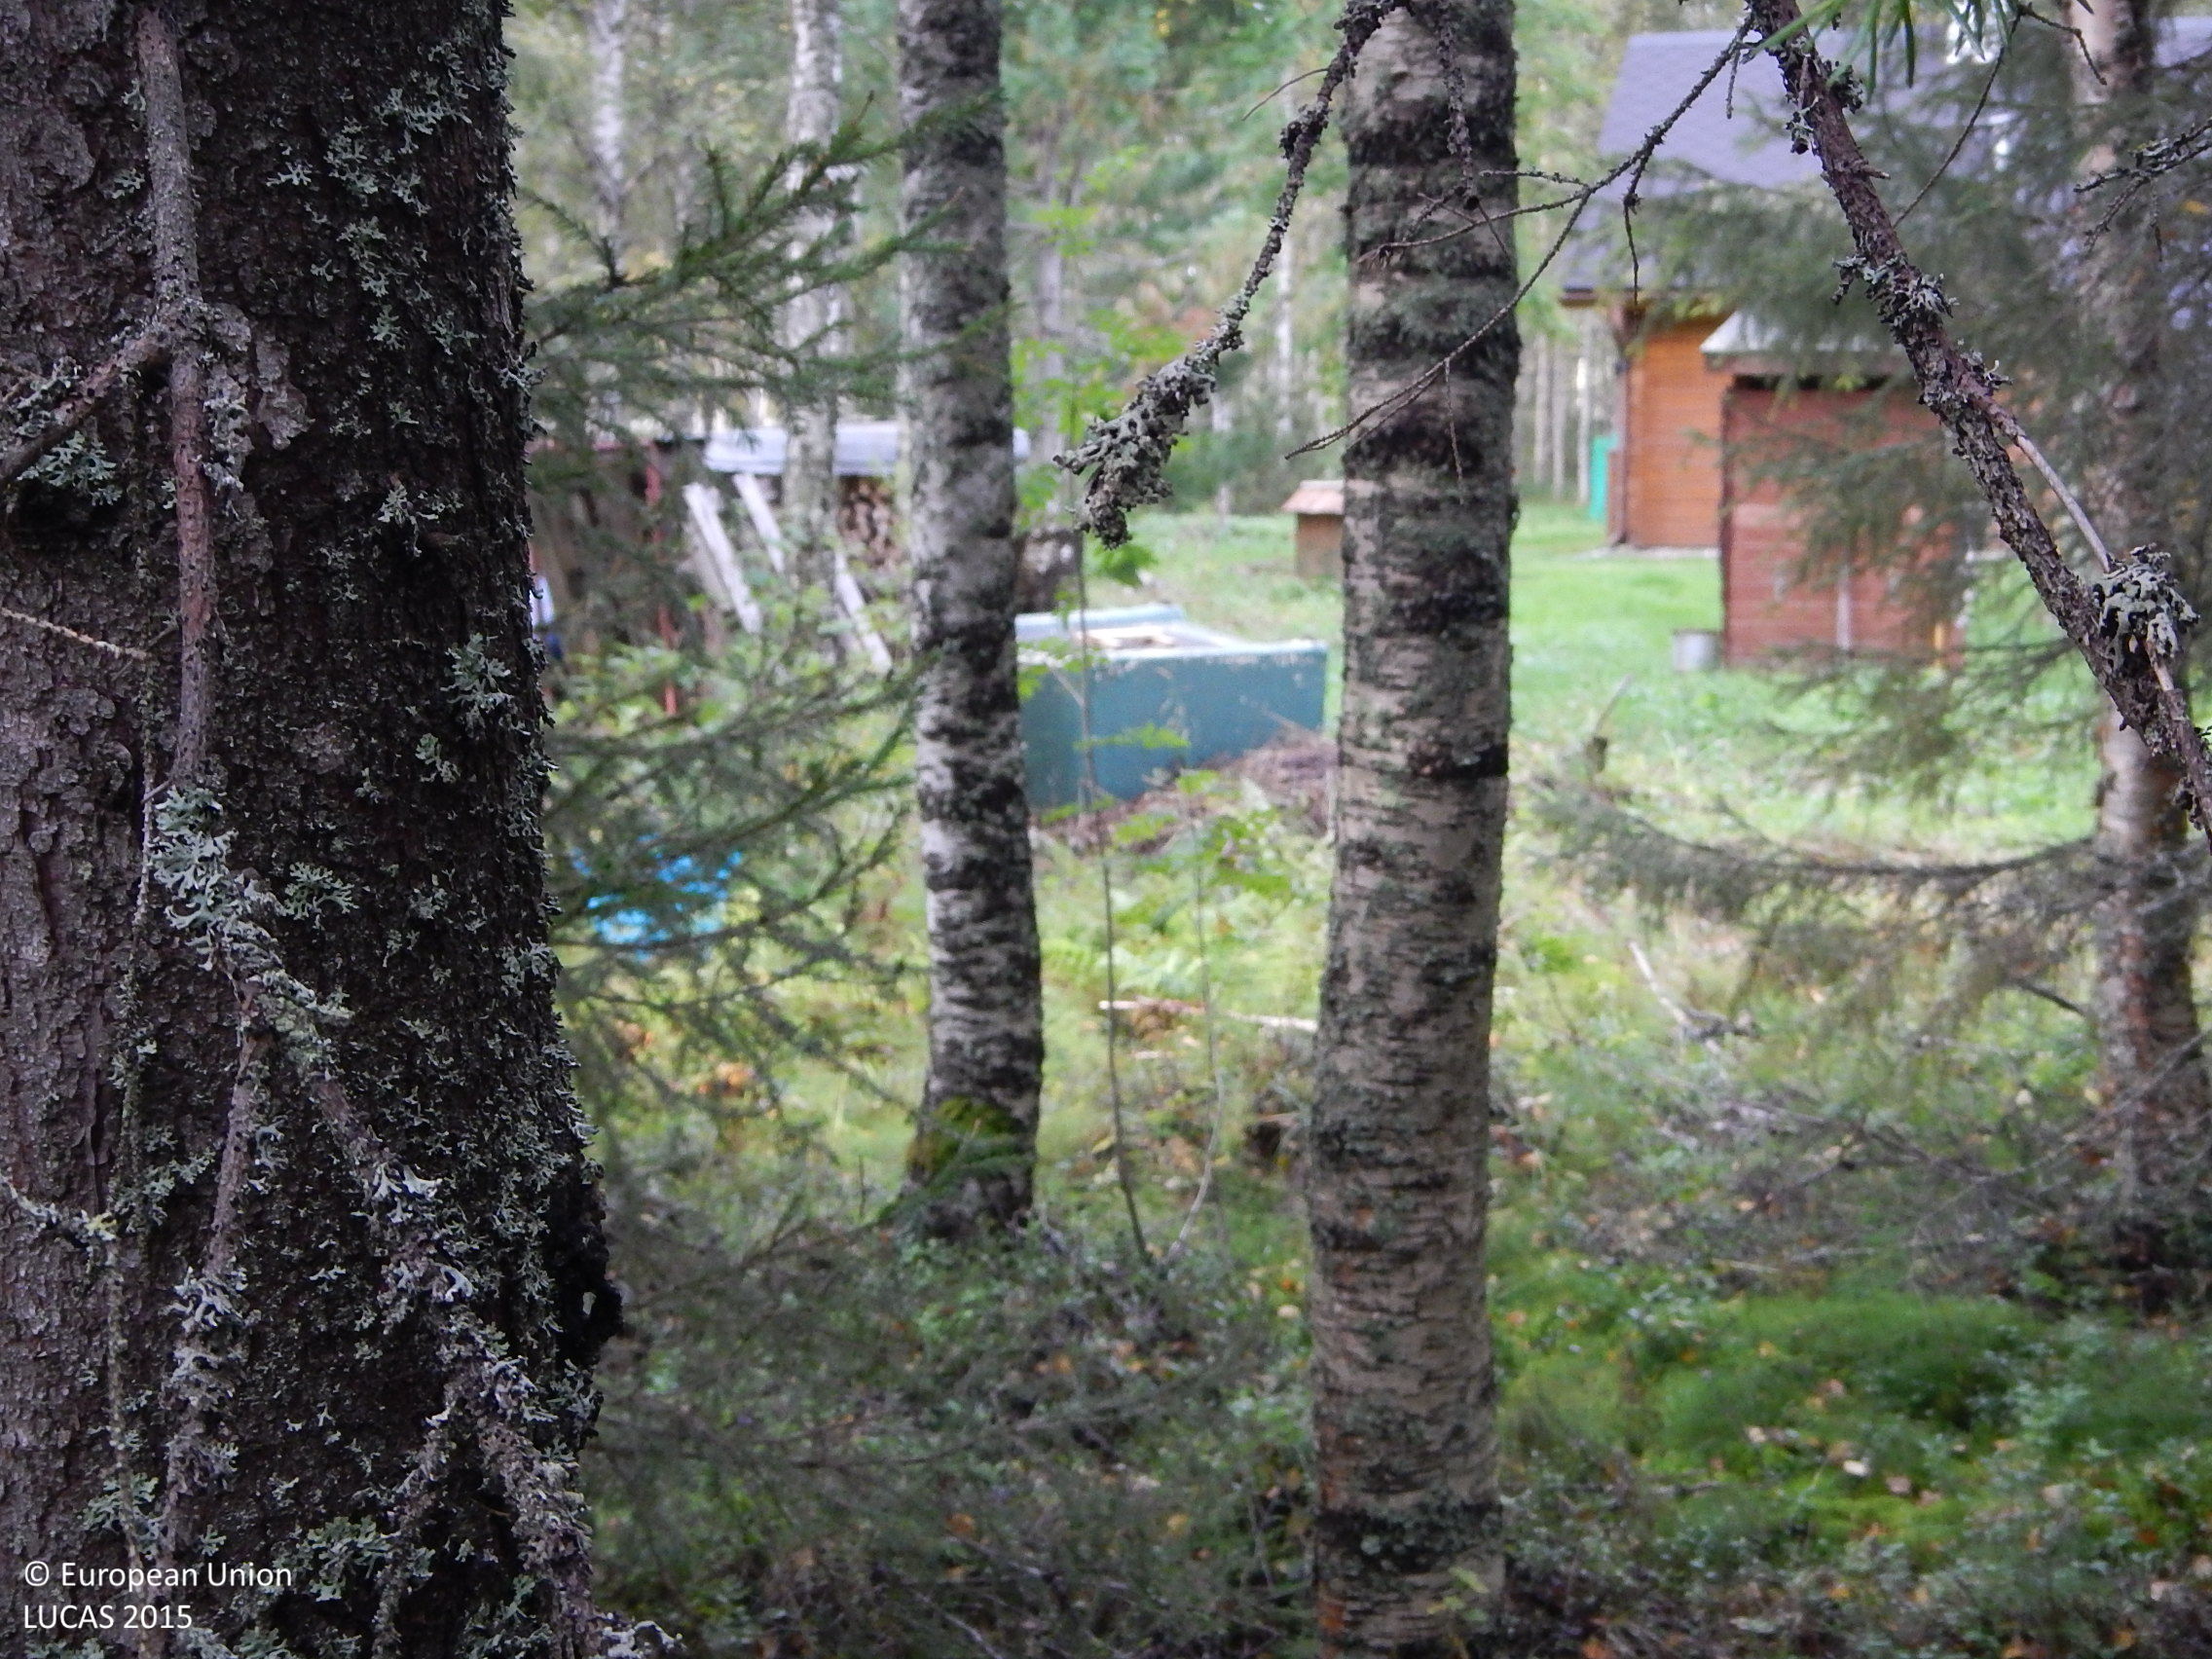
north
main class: Woodland
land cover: Spruce dominated mixed woodland
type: boreal forest
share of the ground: 50 - 75 %
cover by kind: coniferous forest trees 45 %, broadleaved forest trees 25 %, shrubs 25 %, lichens and mosses 5 %
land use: Forestry
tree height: > 5 m
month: August
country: FI
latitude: 65.7018
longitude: 27.3494
